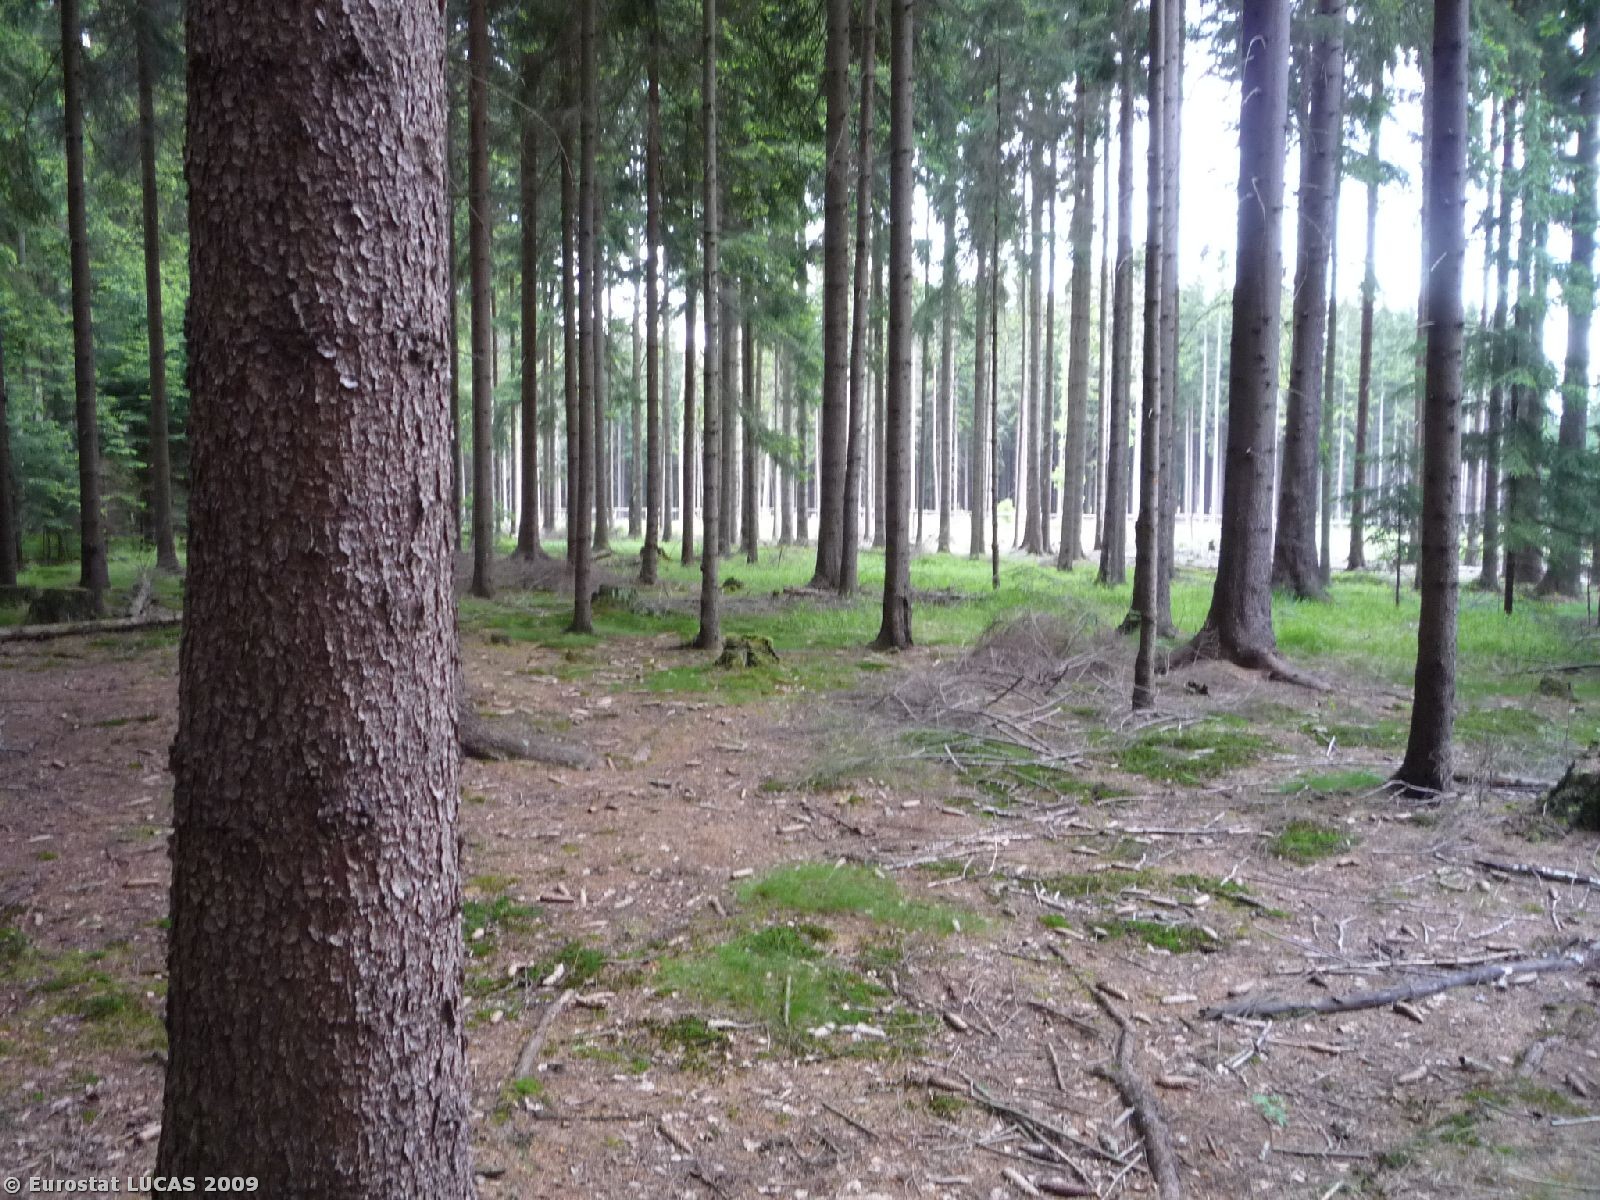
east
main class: Woodland
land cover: Coniferous woodland
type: hemiboreal forest and nemoral coniferous forest and mixed broadleaved-coniferous forest
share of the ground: > 75 %
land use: Forestry
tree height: > 5 m
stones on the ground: < 10 %
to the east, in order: Coniferous woodland; Fences; Coniferous woodland; Fences; Tracks; Coniferous woodland
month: June
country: CZ
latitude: 50.5896
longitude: 15.5555
